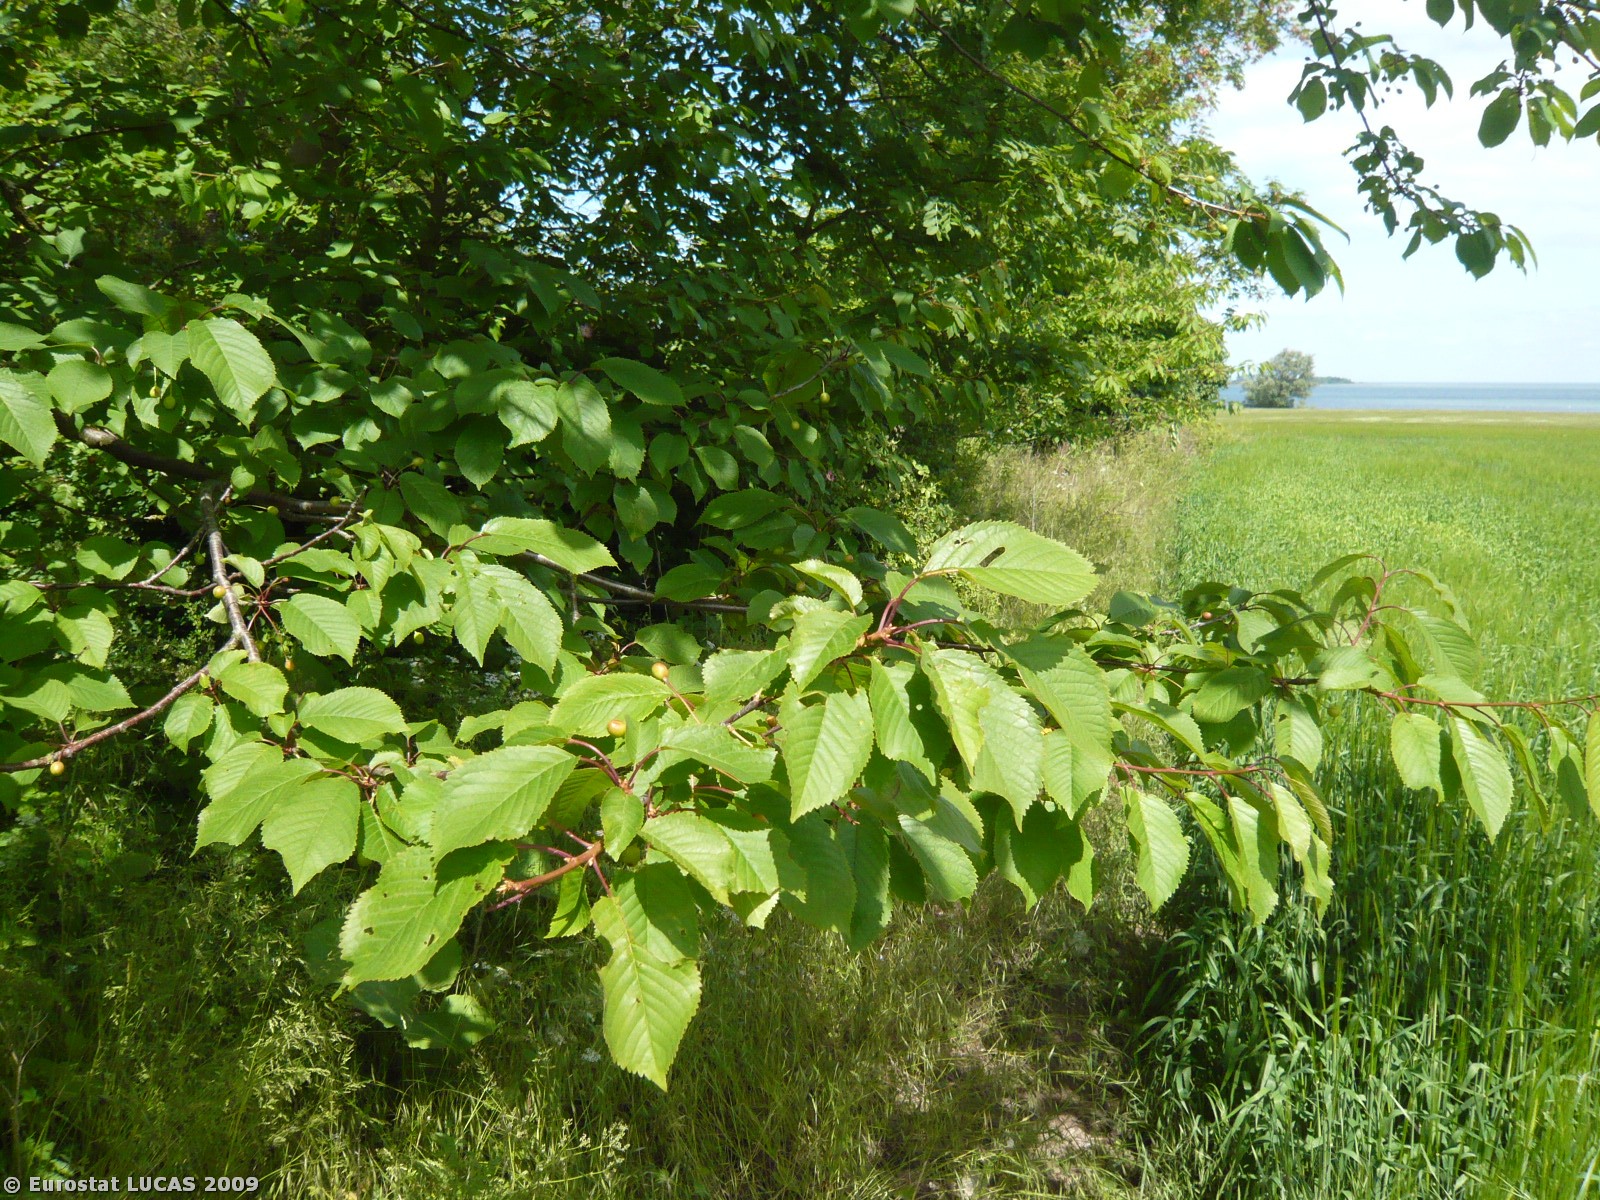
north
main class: Cropland
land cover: Barley
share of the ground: > 75 %
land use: Agriculture (excluding fallow land and kitchen gardens)
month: June
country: DK
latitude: 54.9408
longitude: 11.2947
